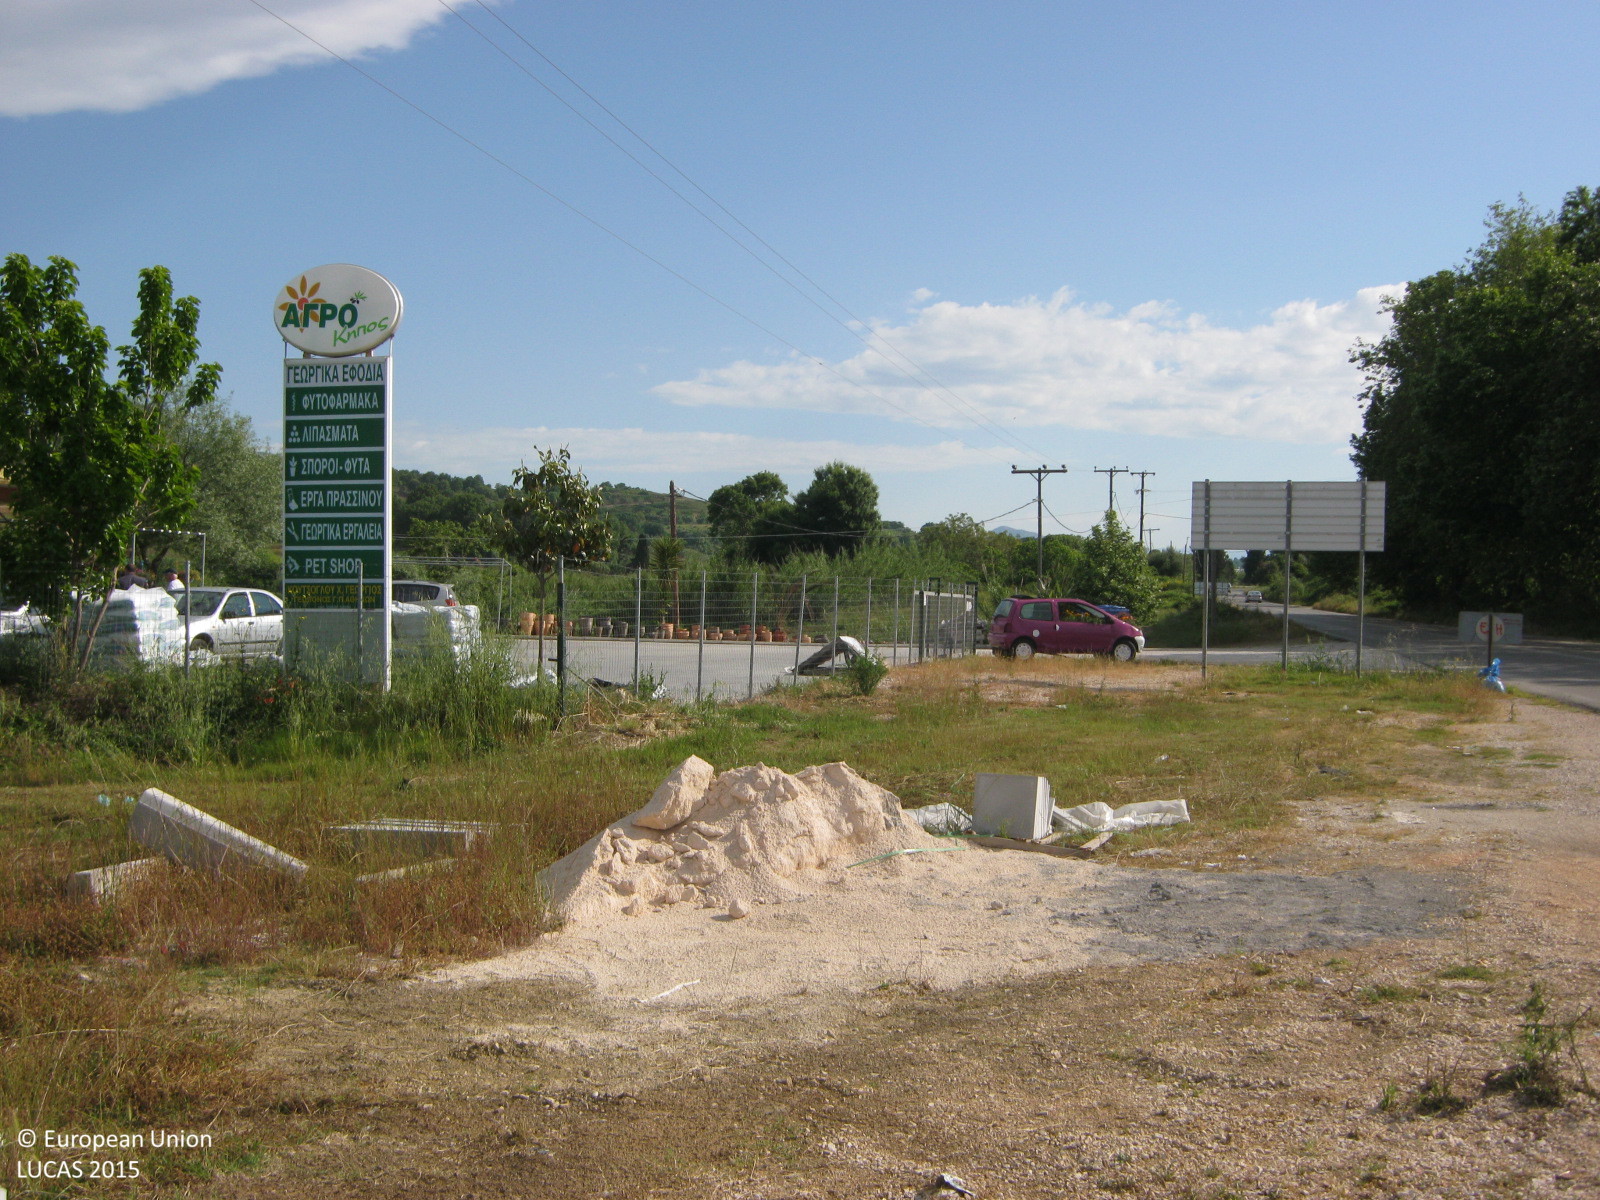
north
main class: Grassland
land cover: Grassland without tree/shrub cover
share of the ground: > 75 %
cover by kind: herbaceous plants 60 %, consolidated bare surface 20 %
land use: Abandoned areas
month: May
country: GR
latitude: 39.0798
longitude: 20.6872
